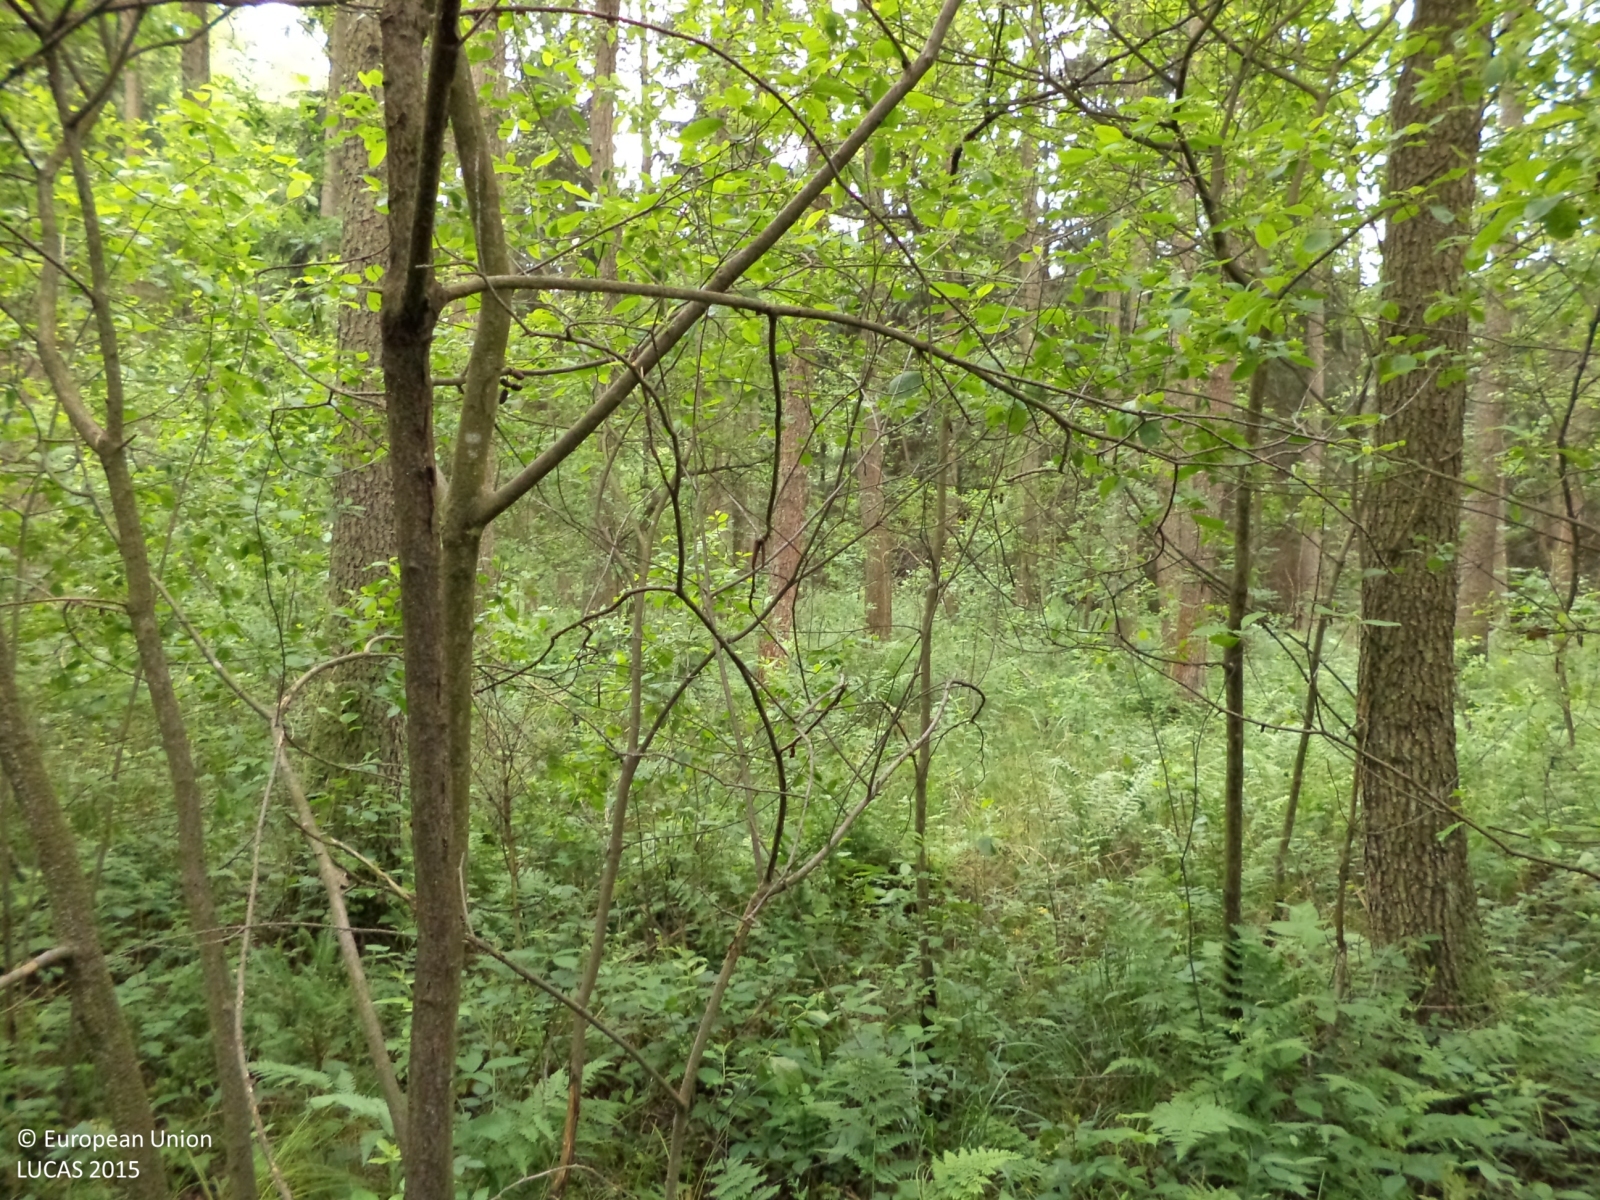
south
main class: Woodland
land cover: Other mixed woodland
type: hemiboreal forest and nemoral coniferous forest and mixed broadleaved-coniferous forest
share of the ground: > 75 %
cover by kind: broadleaved forest trees 55 %, coniferous forest trees 25 %, shrubs 10 %, herbaceous plants 10 %
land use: Forestry
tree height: > 5 m
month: June
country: CZ
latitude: 49.2218
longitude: 14.2710
